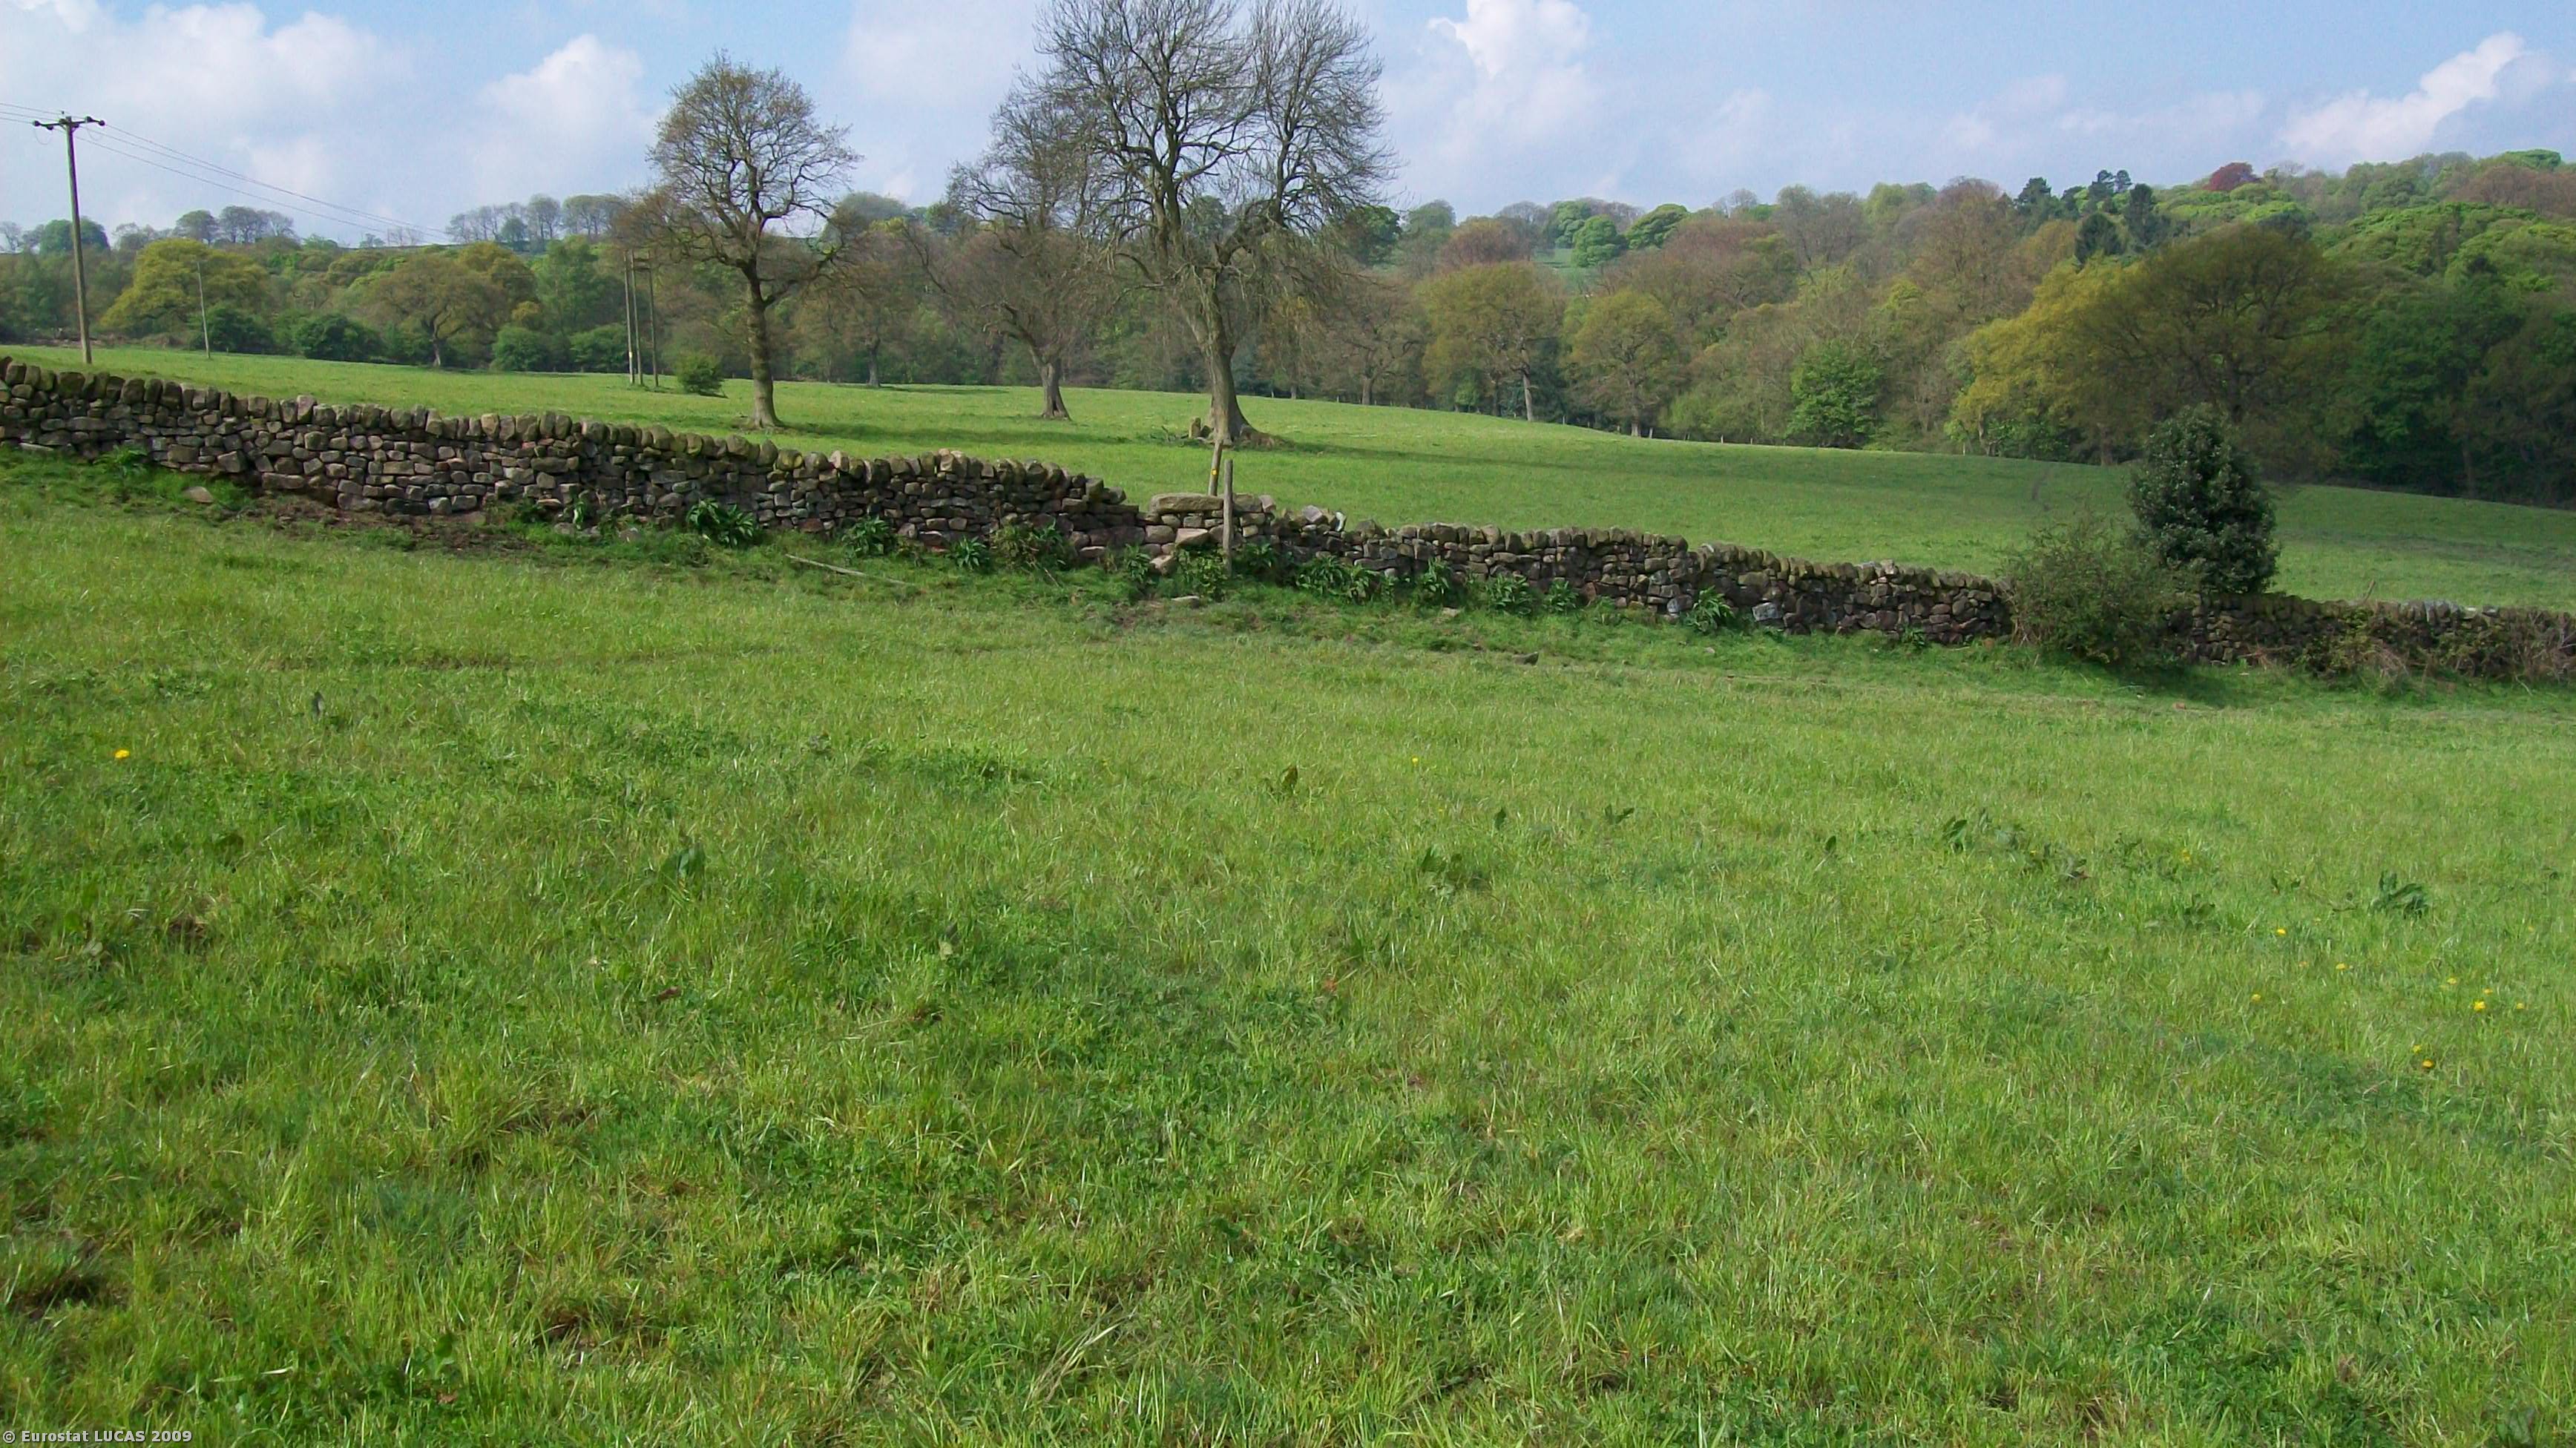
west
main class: Grassland
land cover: Grassland without tree/shrub cover
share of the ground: > 75 %
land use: Agriculture (excluding fallow land and kitchen gardens)
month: April
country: GB
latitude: 53.0851
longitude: -1.5321
